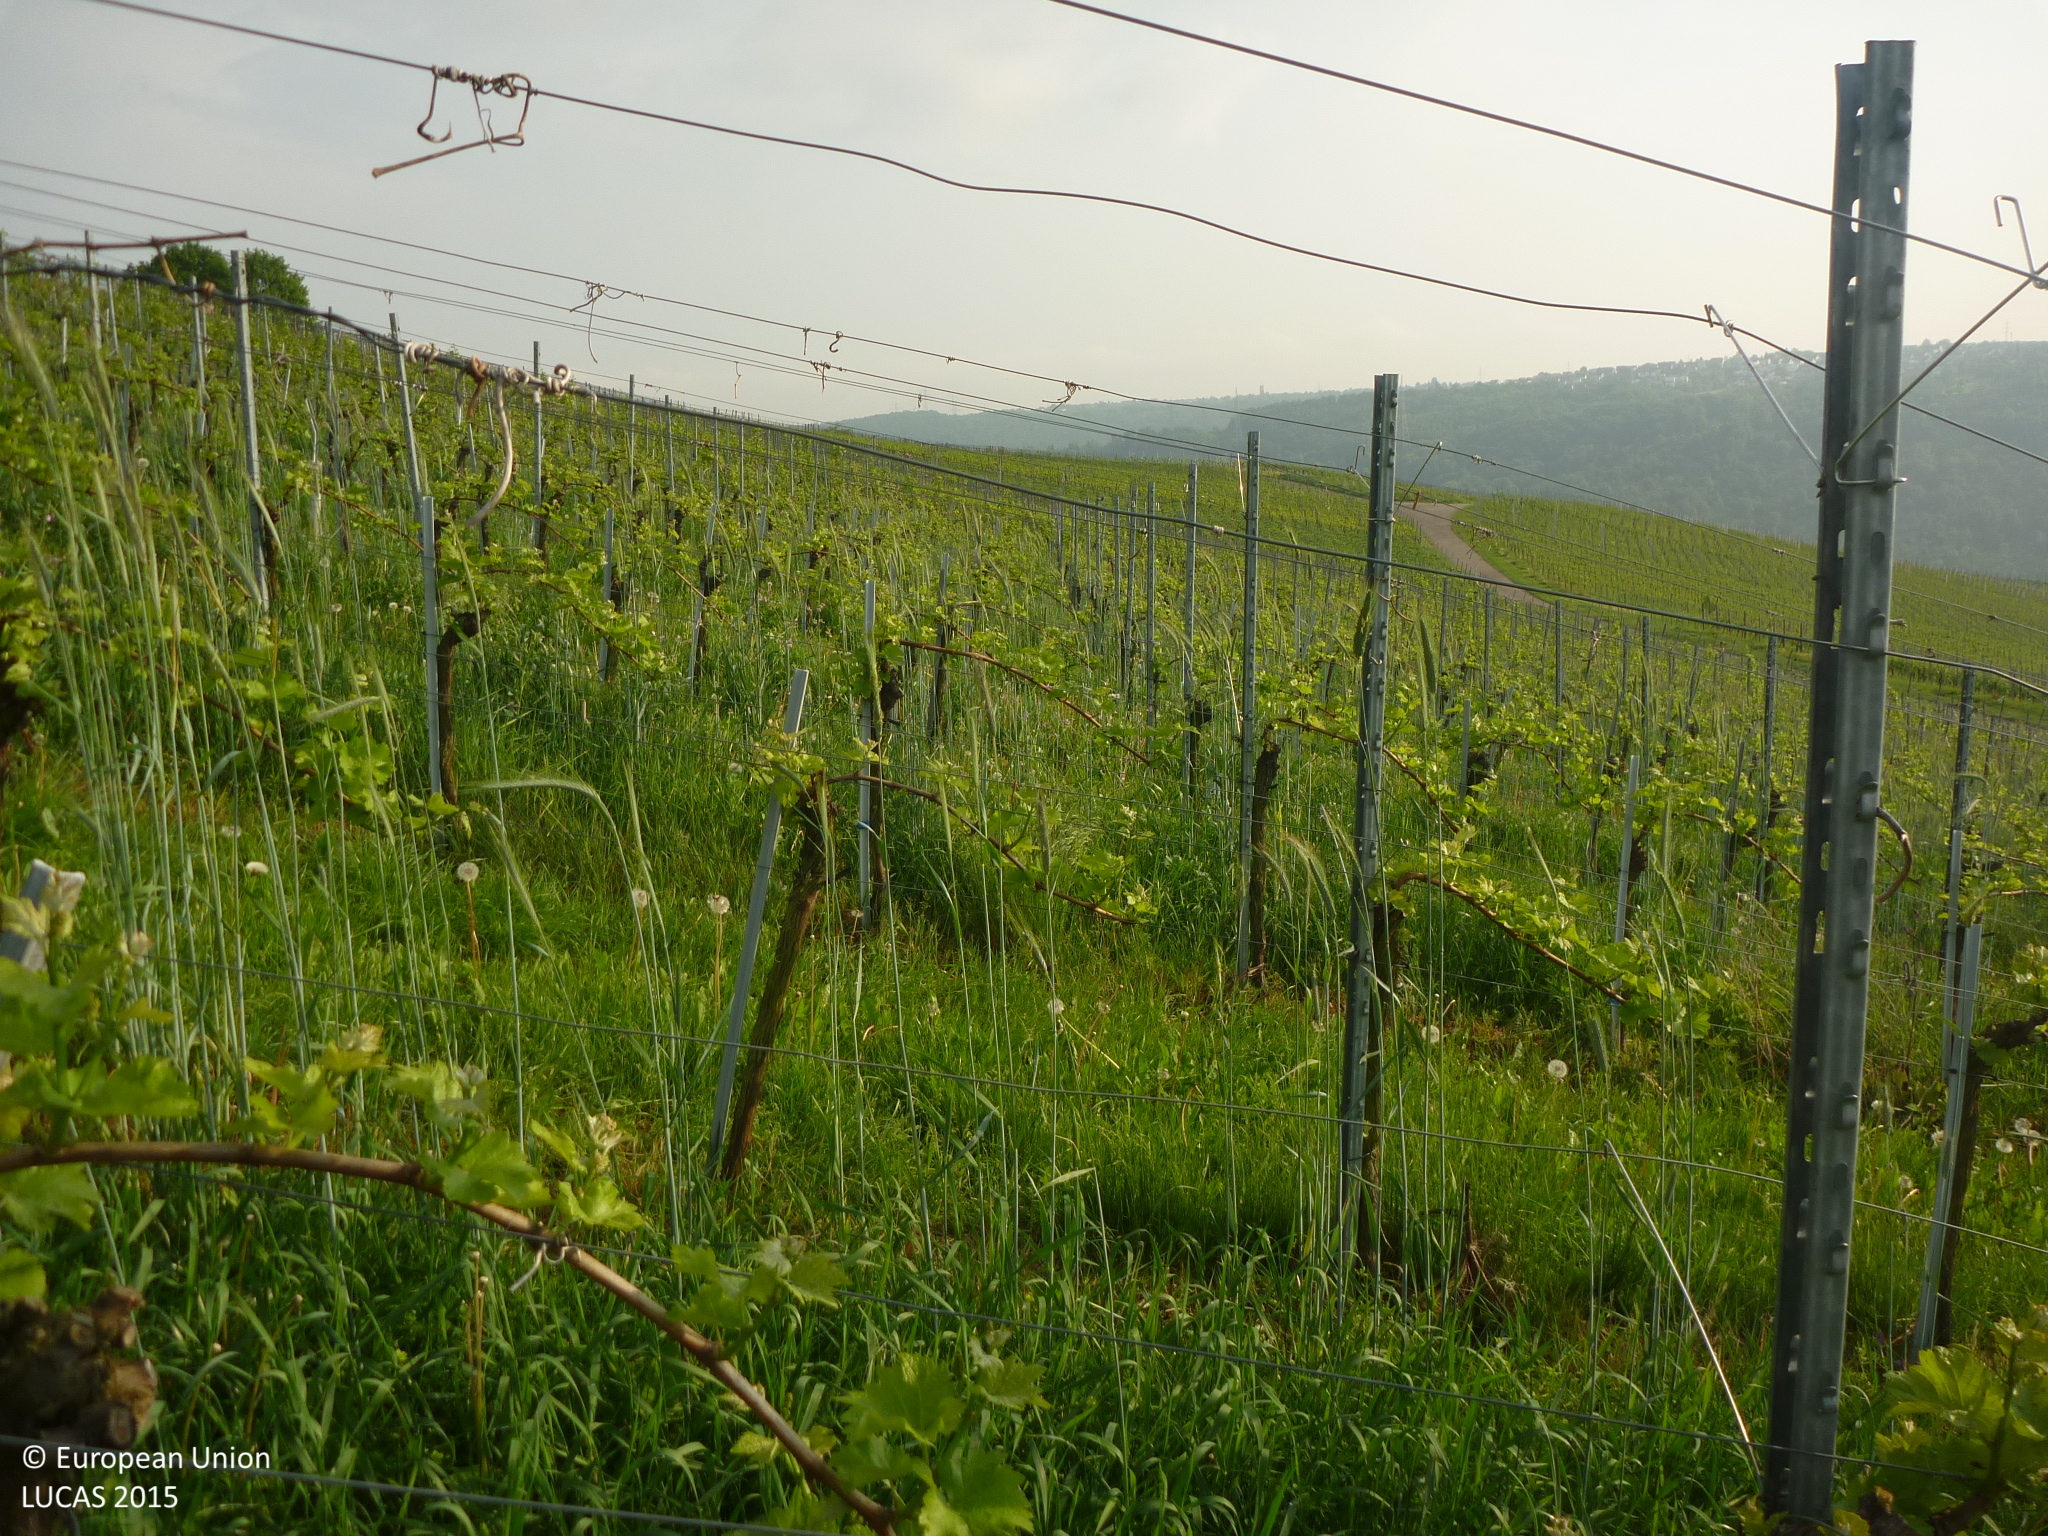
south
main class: Cropland
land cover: Vineyards
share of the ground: 10 - 25 %
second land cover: Grassland without tree/shrub cover
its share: > 75 %
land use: Agriculture (excluding fallow land and kitchen gardens)
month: May
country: DE
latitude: 48.7978
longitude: 9.4149
